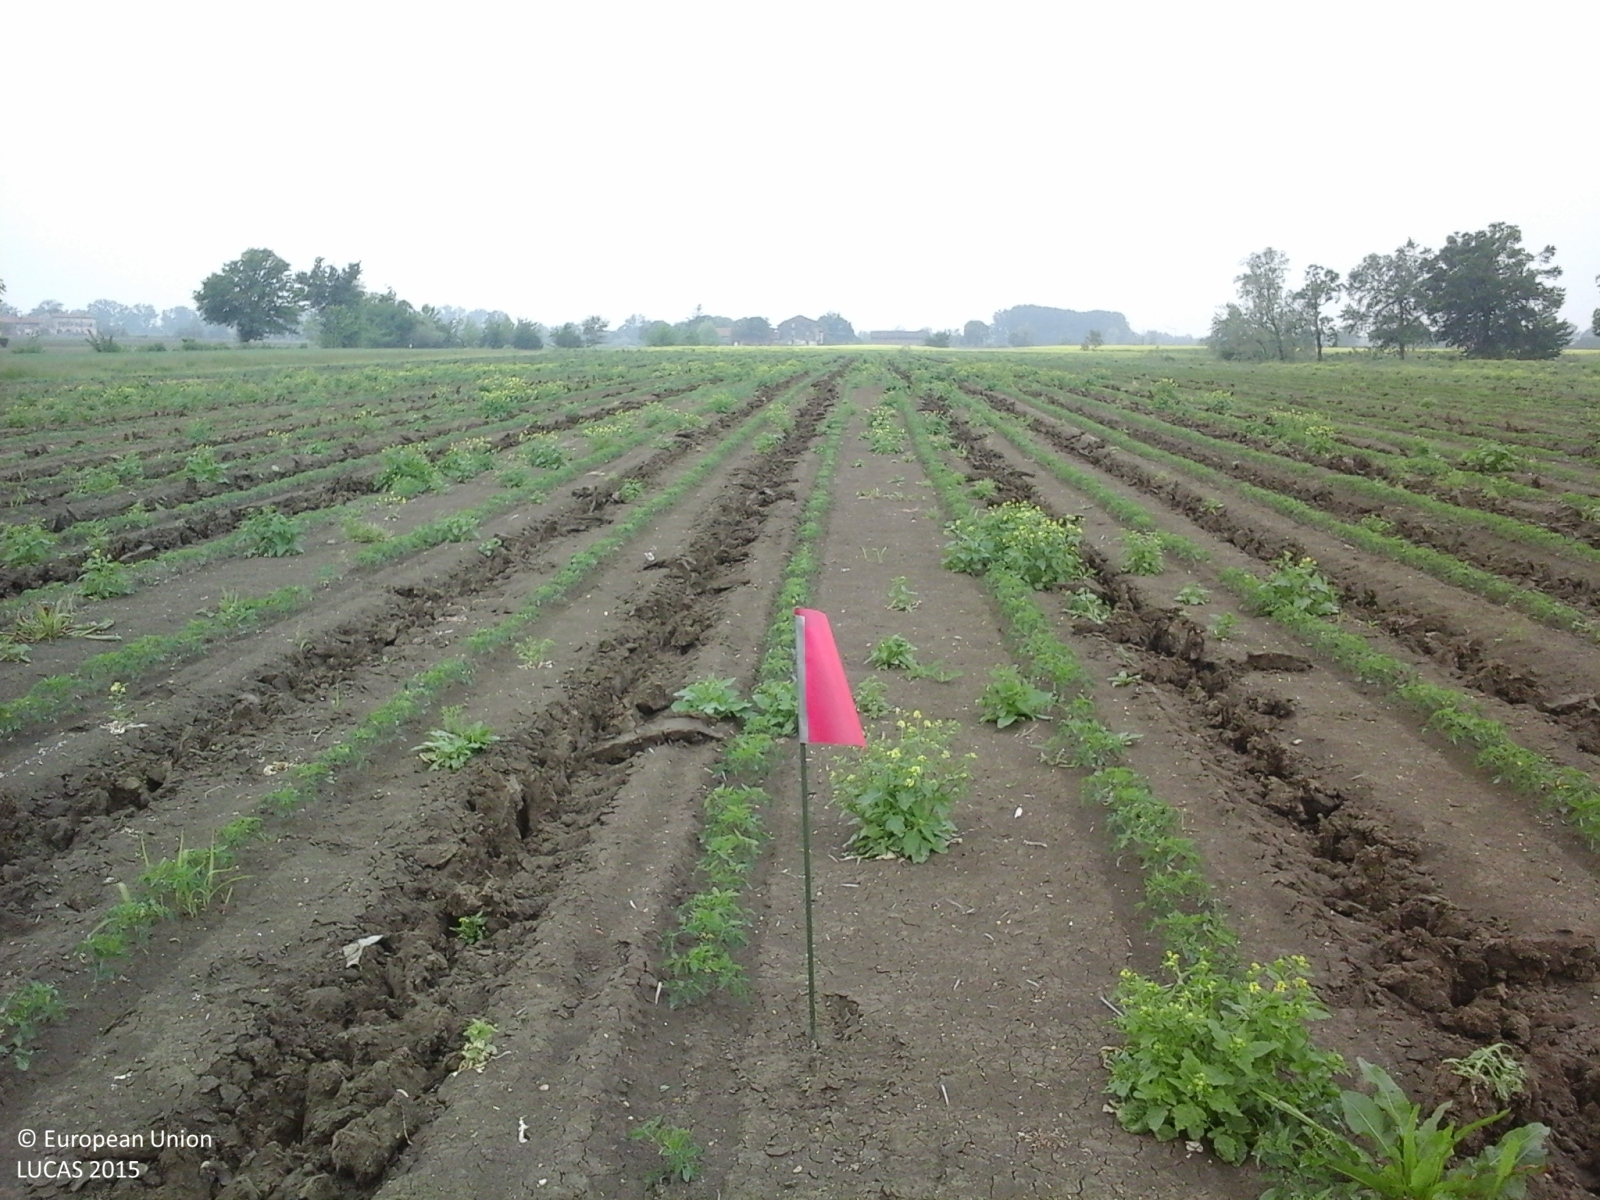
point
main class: Cropland
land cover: Tomatoes
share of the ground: 10 - 25 %
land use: Agriculture (excluding fallow land and kitchen gardens)
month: May
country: IT
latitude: 45.0342
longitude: 10.5701
